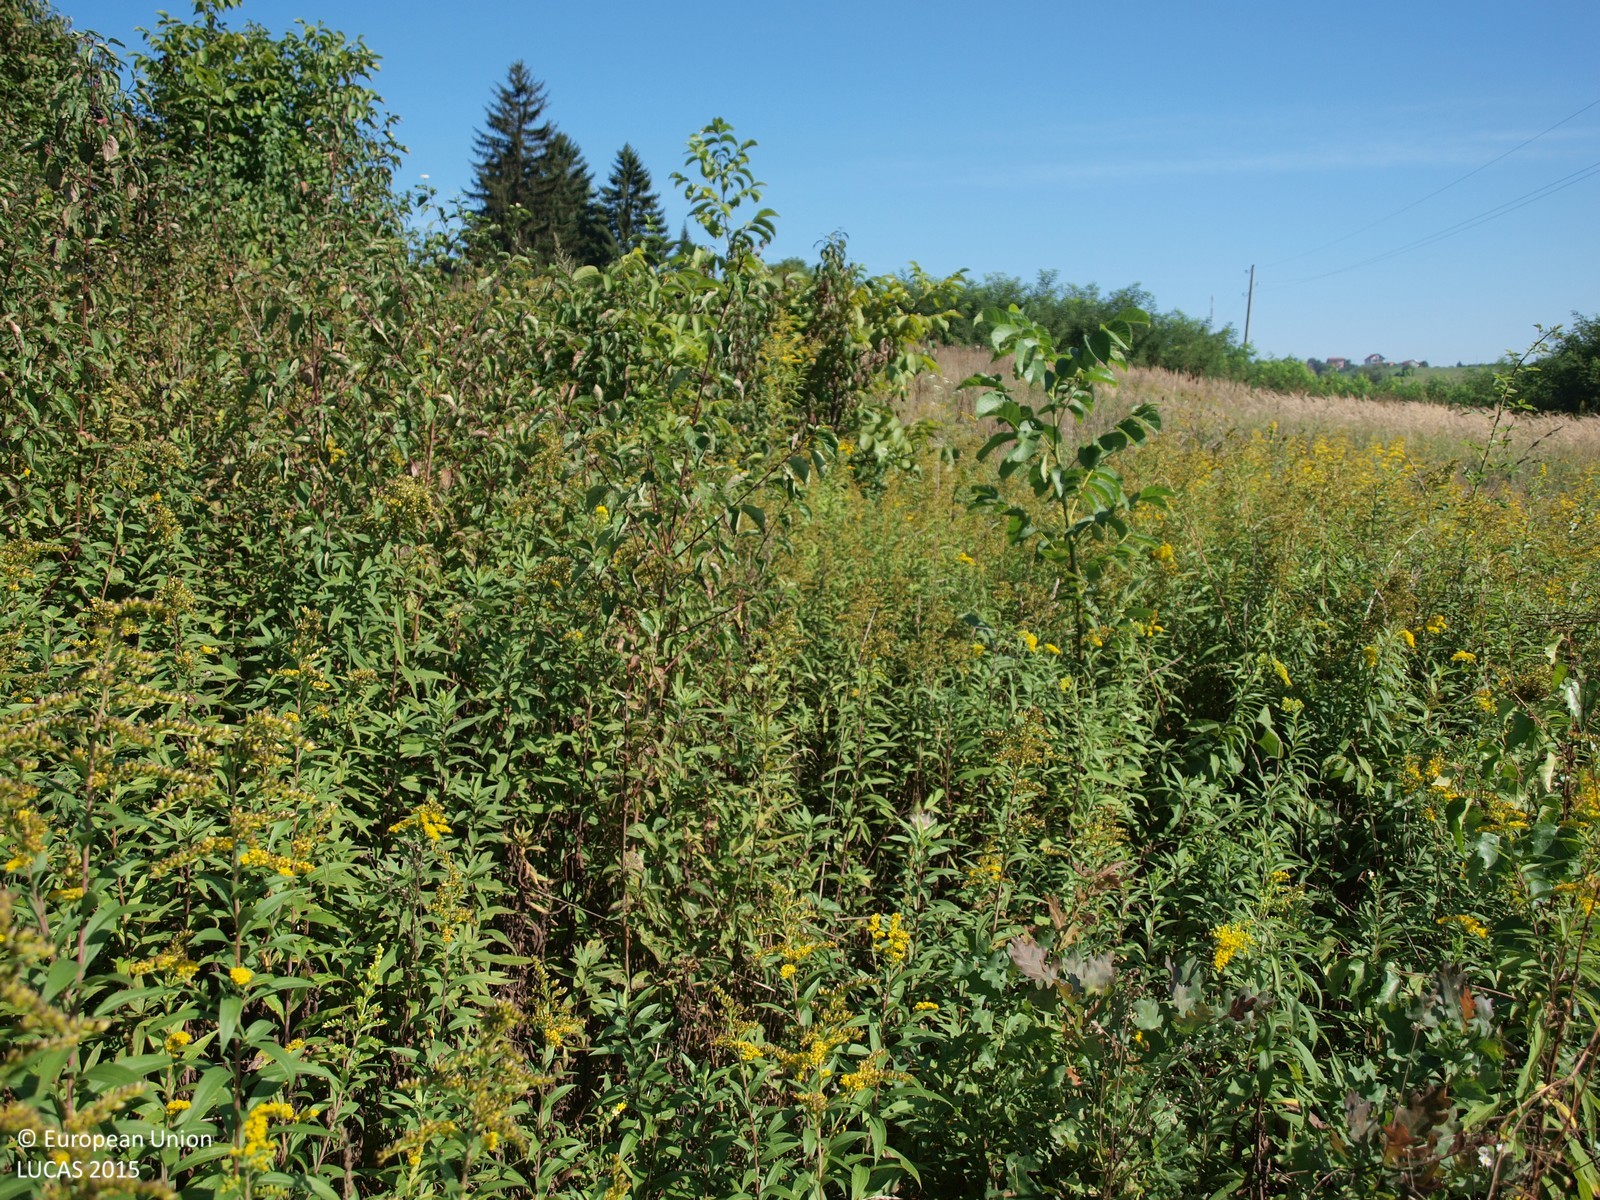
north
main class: Shrubland
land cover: Shrubland with sparse tree cover
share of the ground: > 75 %
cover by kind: shrubs 95 %, broadleaved forest trees 5 %
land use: Semi-natural and natural areas not in use
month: August
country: HR
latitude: 46.0909
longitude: 16.6353
